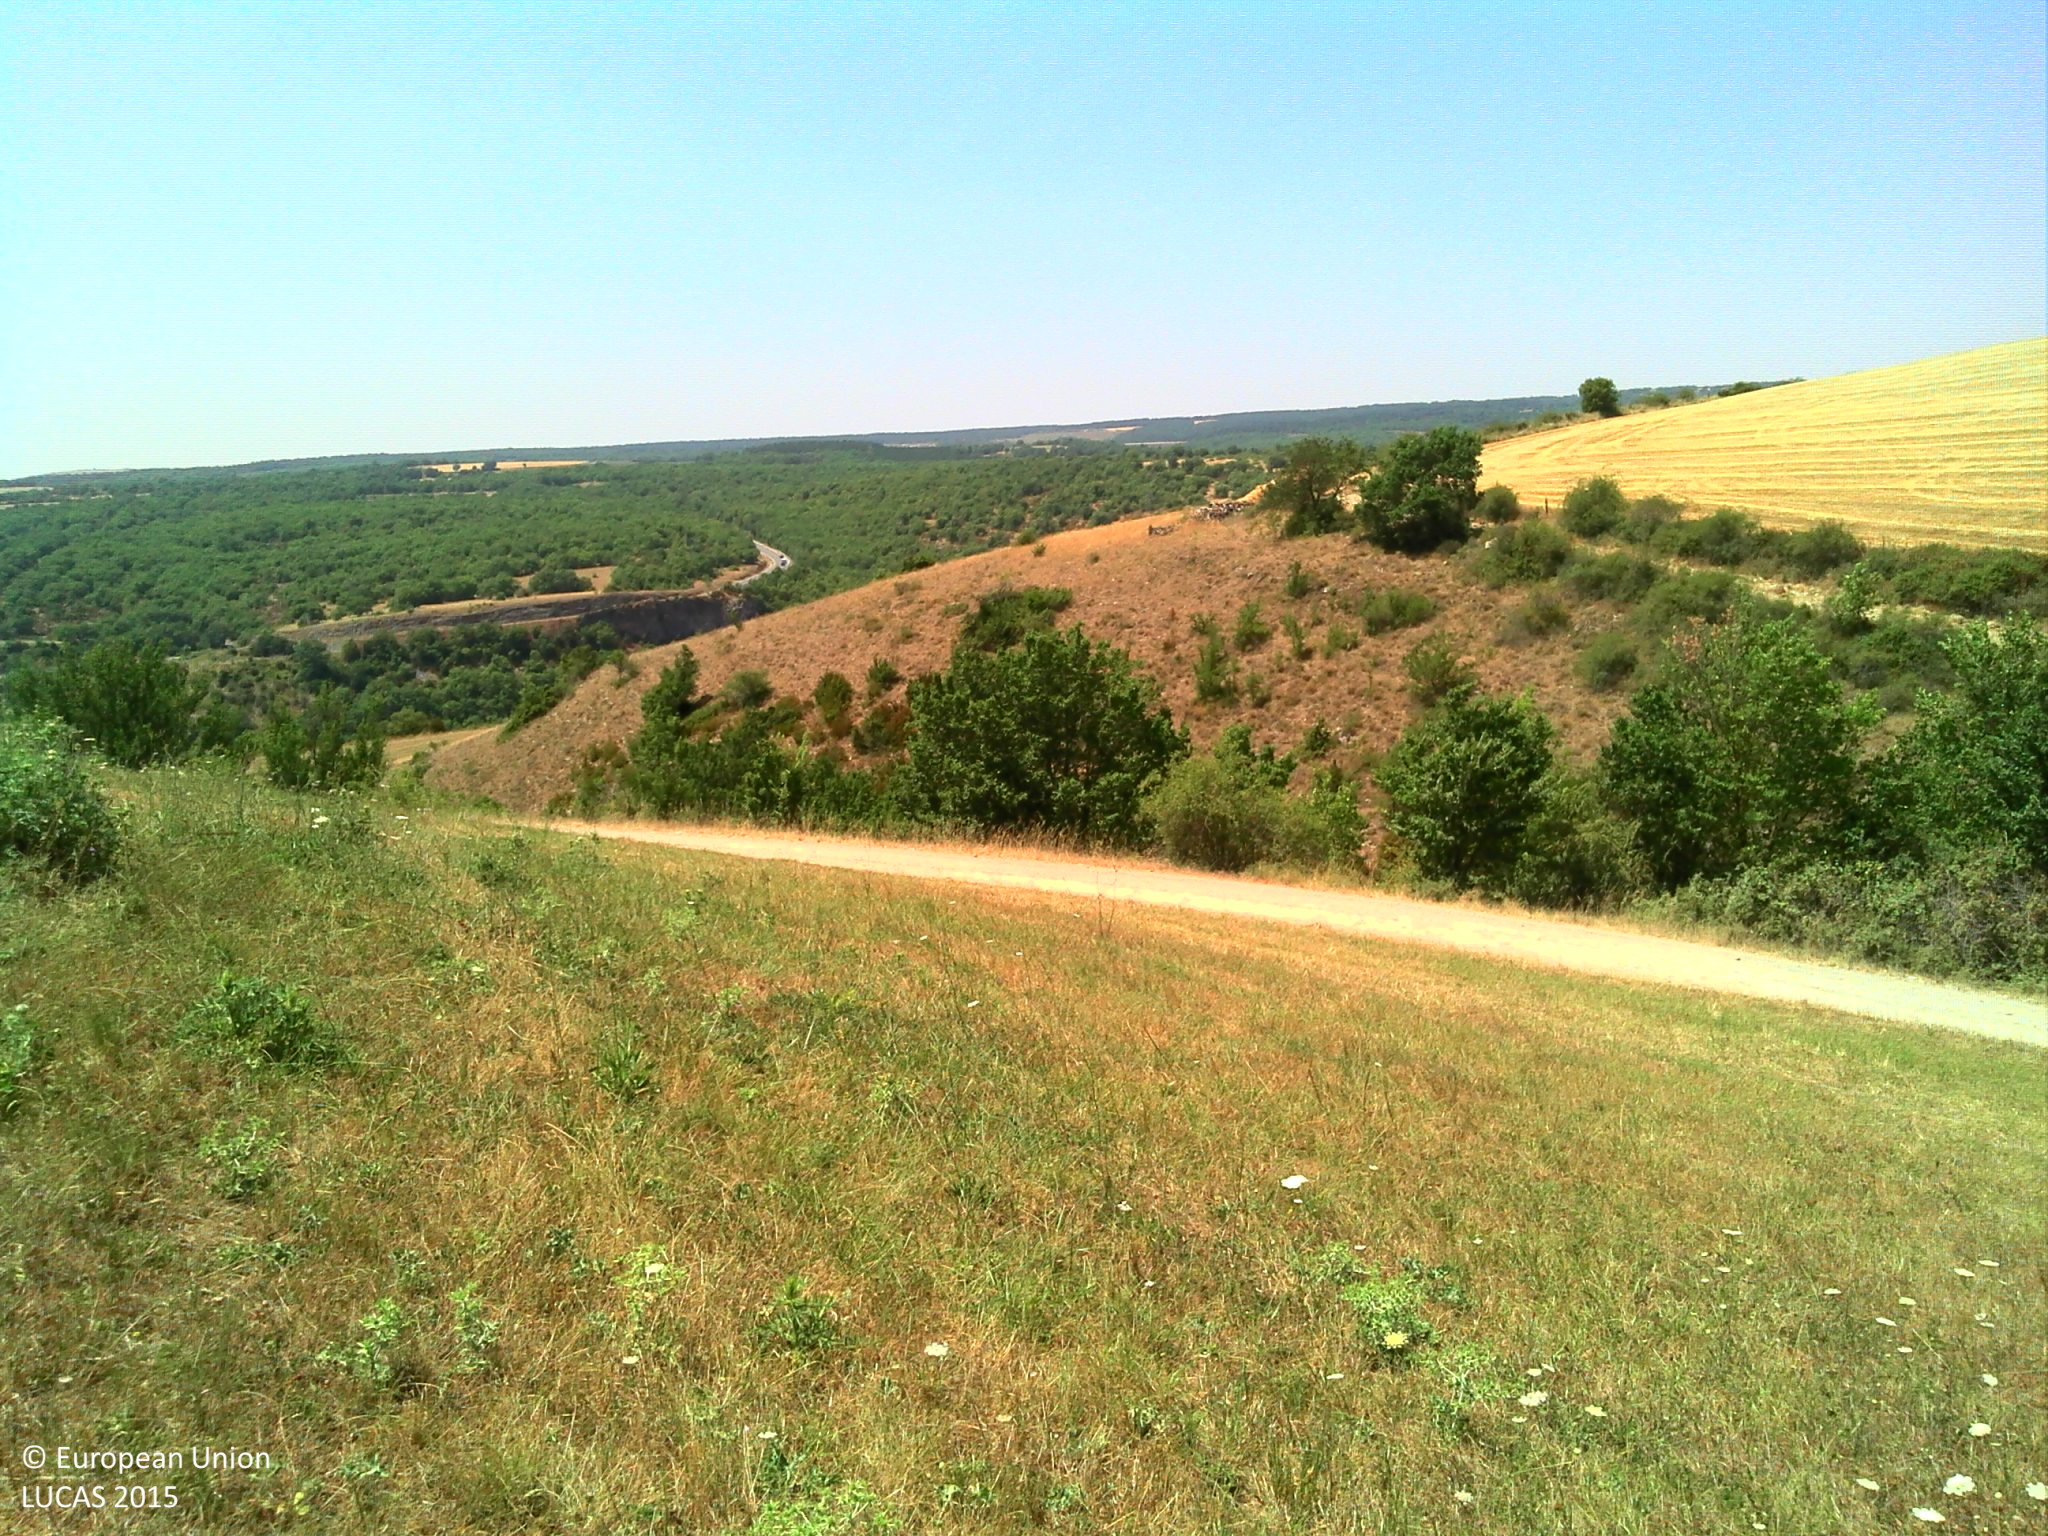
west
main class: Grassland
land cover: Grassland without tree/shrub cover
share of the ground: > 75 %
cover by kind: herbaceous plants 100 %
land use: Agriculture (excluding fallow land and kitchen gardens)
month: July
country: FR
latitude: 44.1743
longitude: 3.0889
